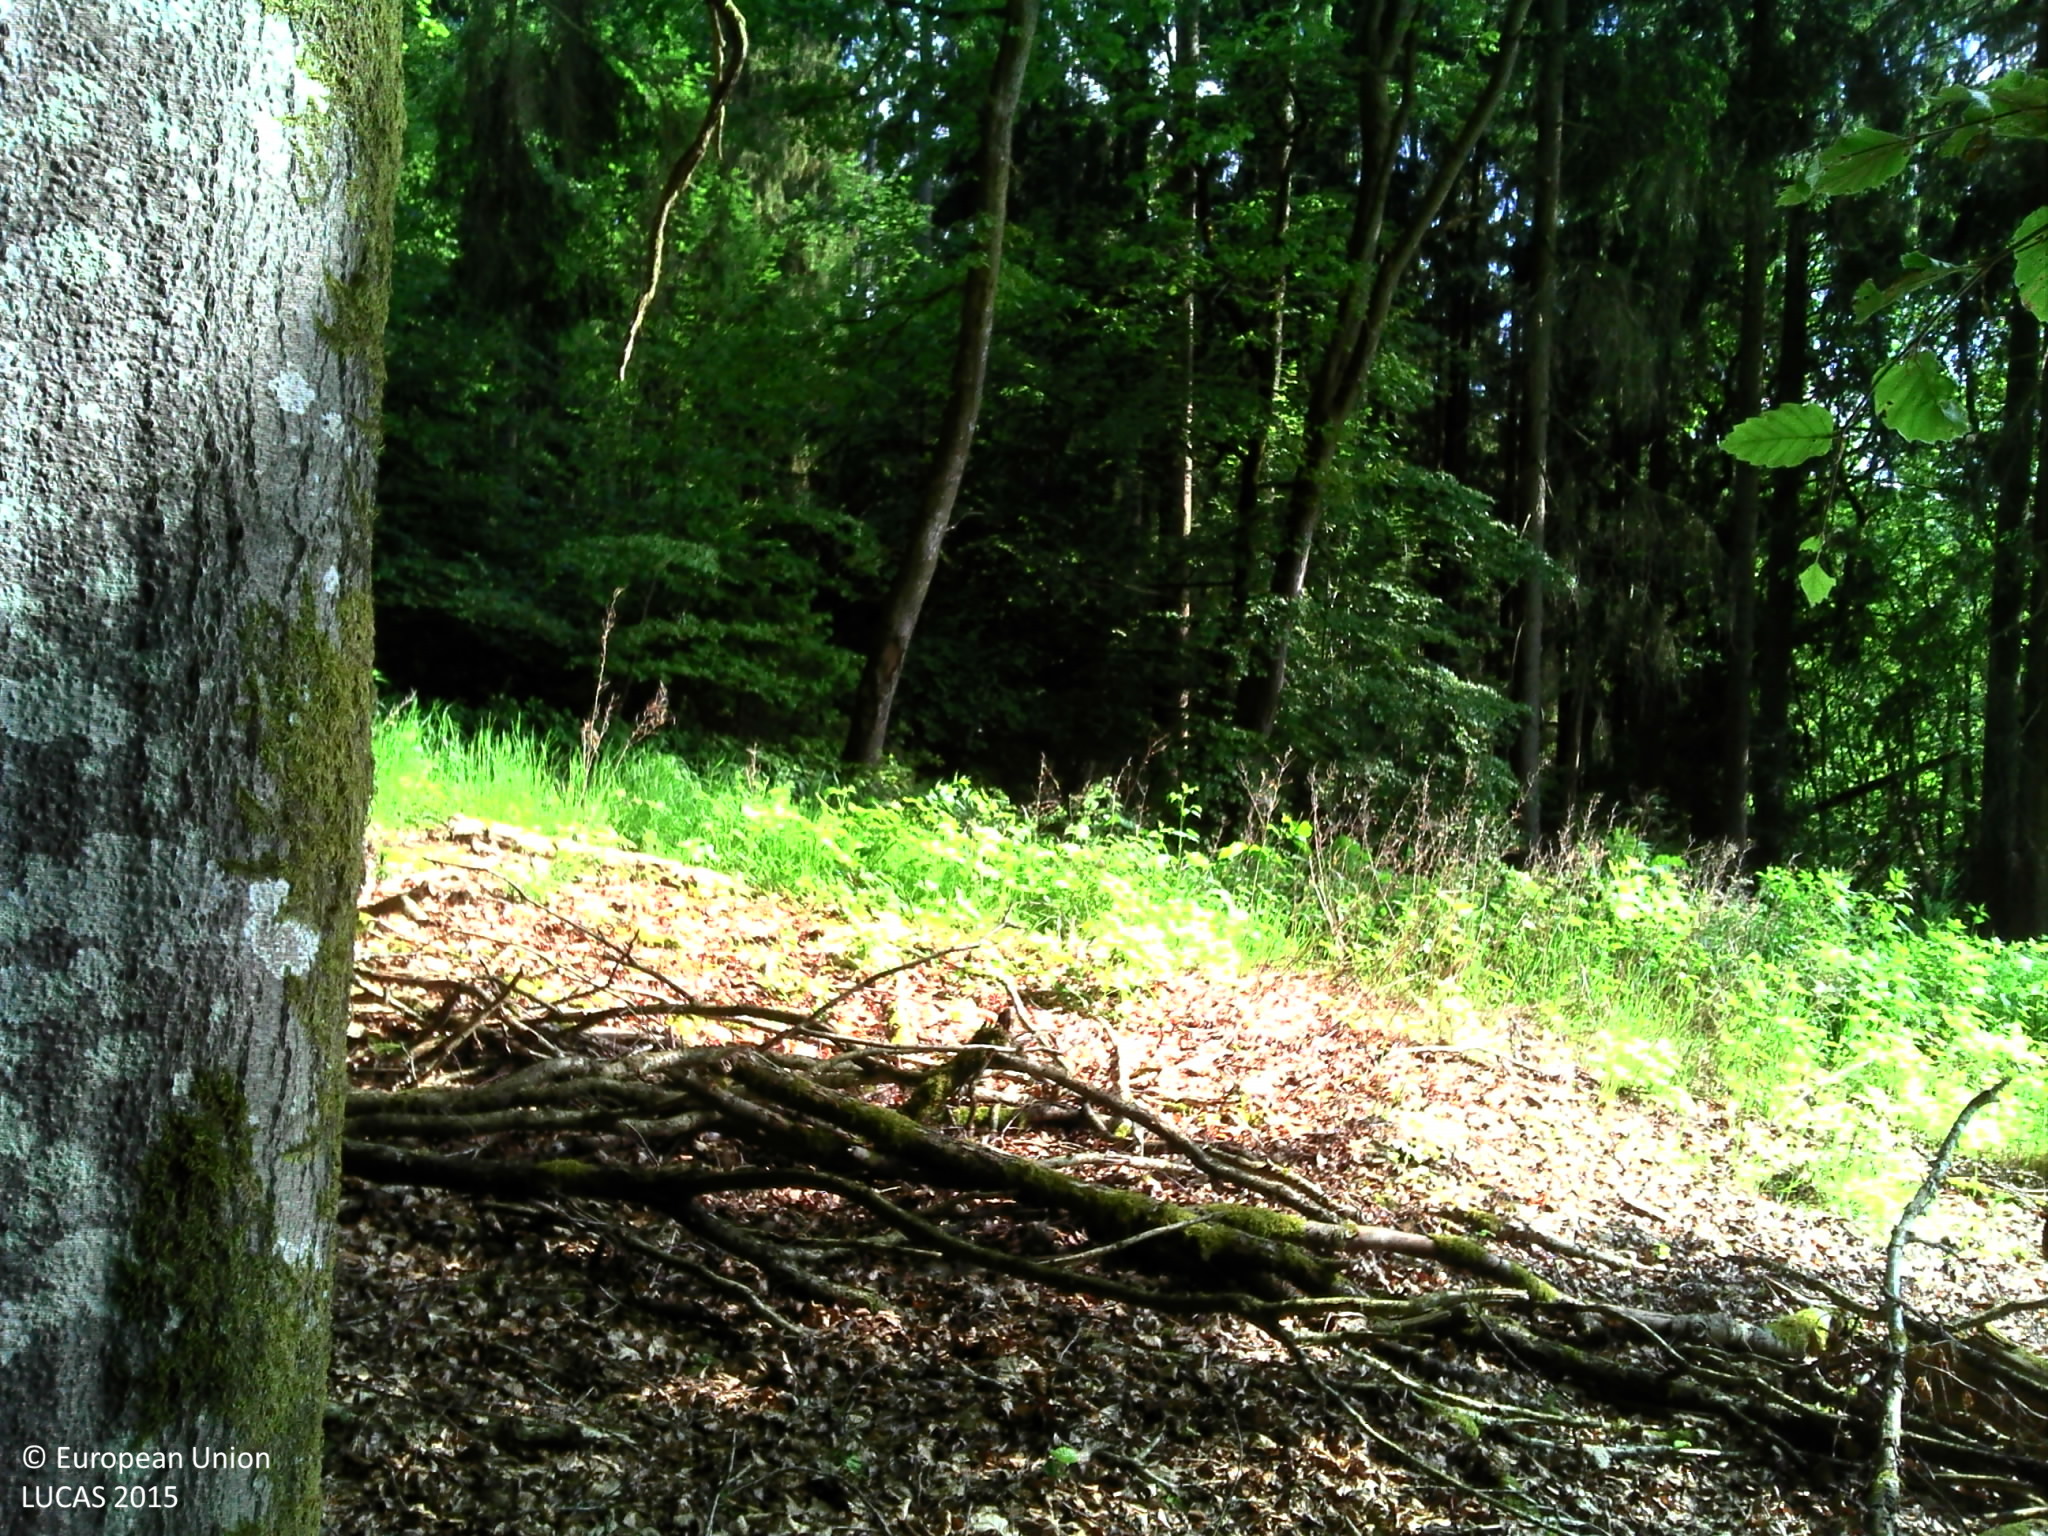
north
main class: Woodland
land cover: Broadleaved woodland
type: acidophilous oak and oak-birch forest
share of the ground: > 75 %
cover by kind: broadleaved forest trees 95 %, lichens and mosses 5 %
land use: Forestry
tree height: > 5 m
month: May
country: LU
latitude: 49.8802
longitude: 6.0051
